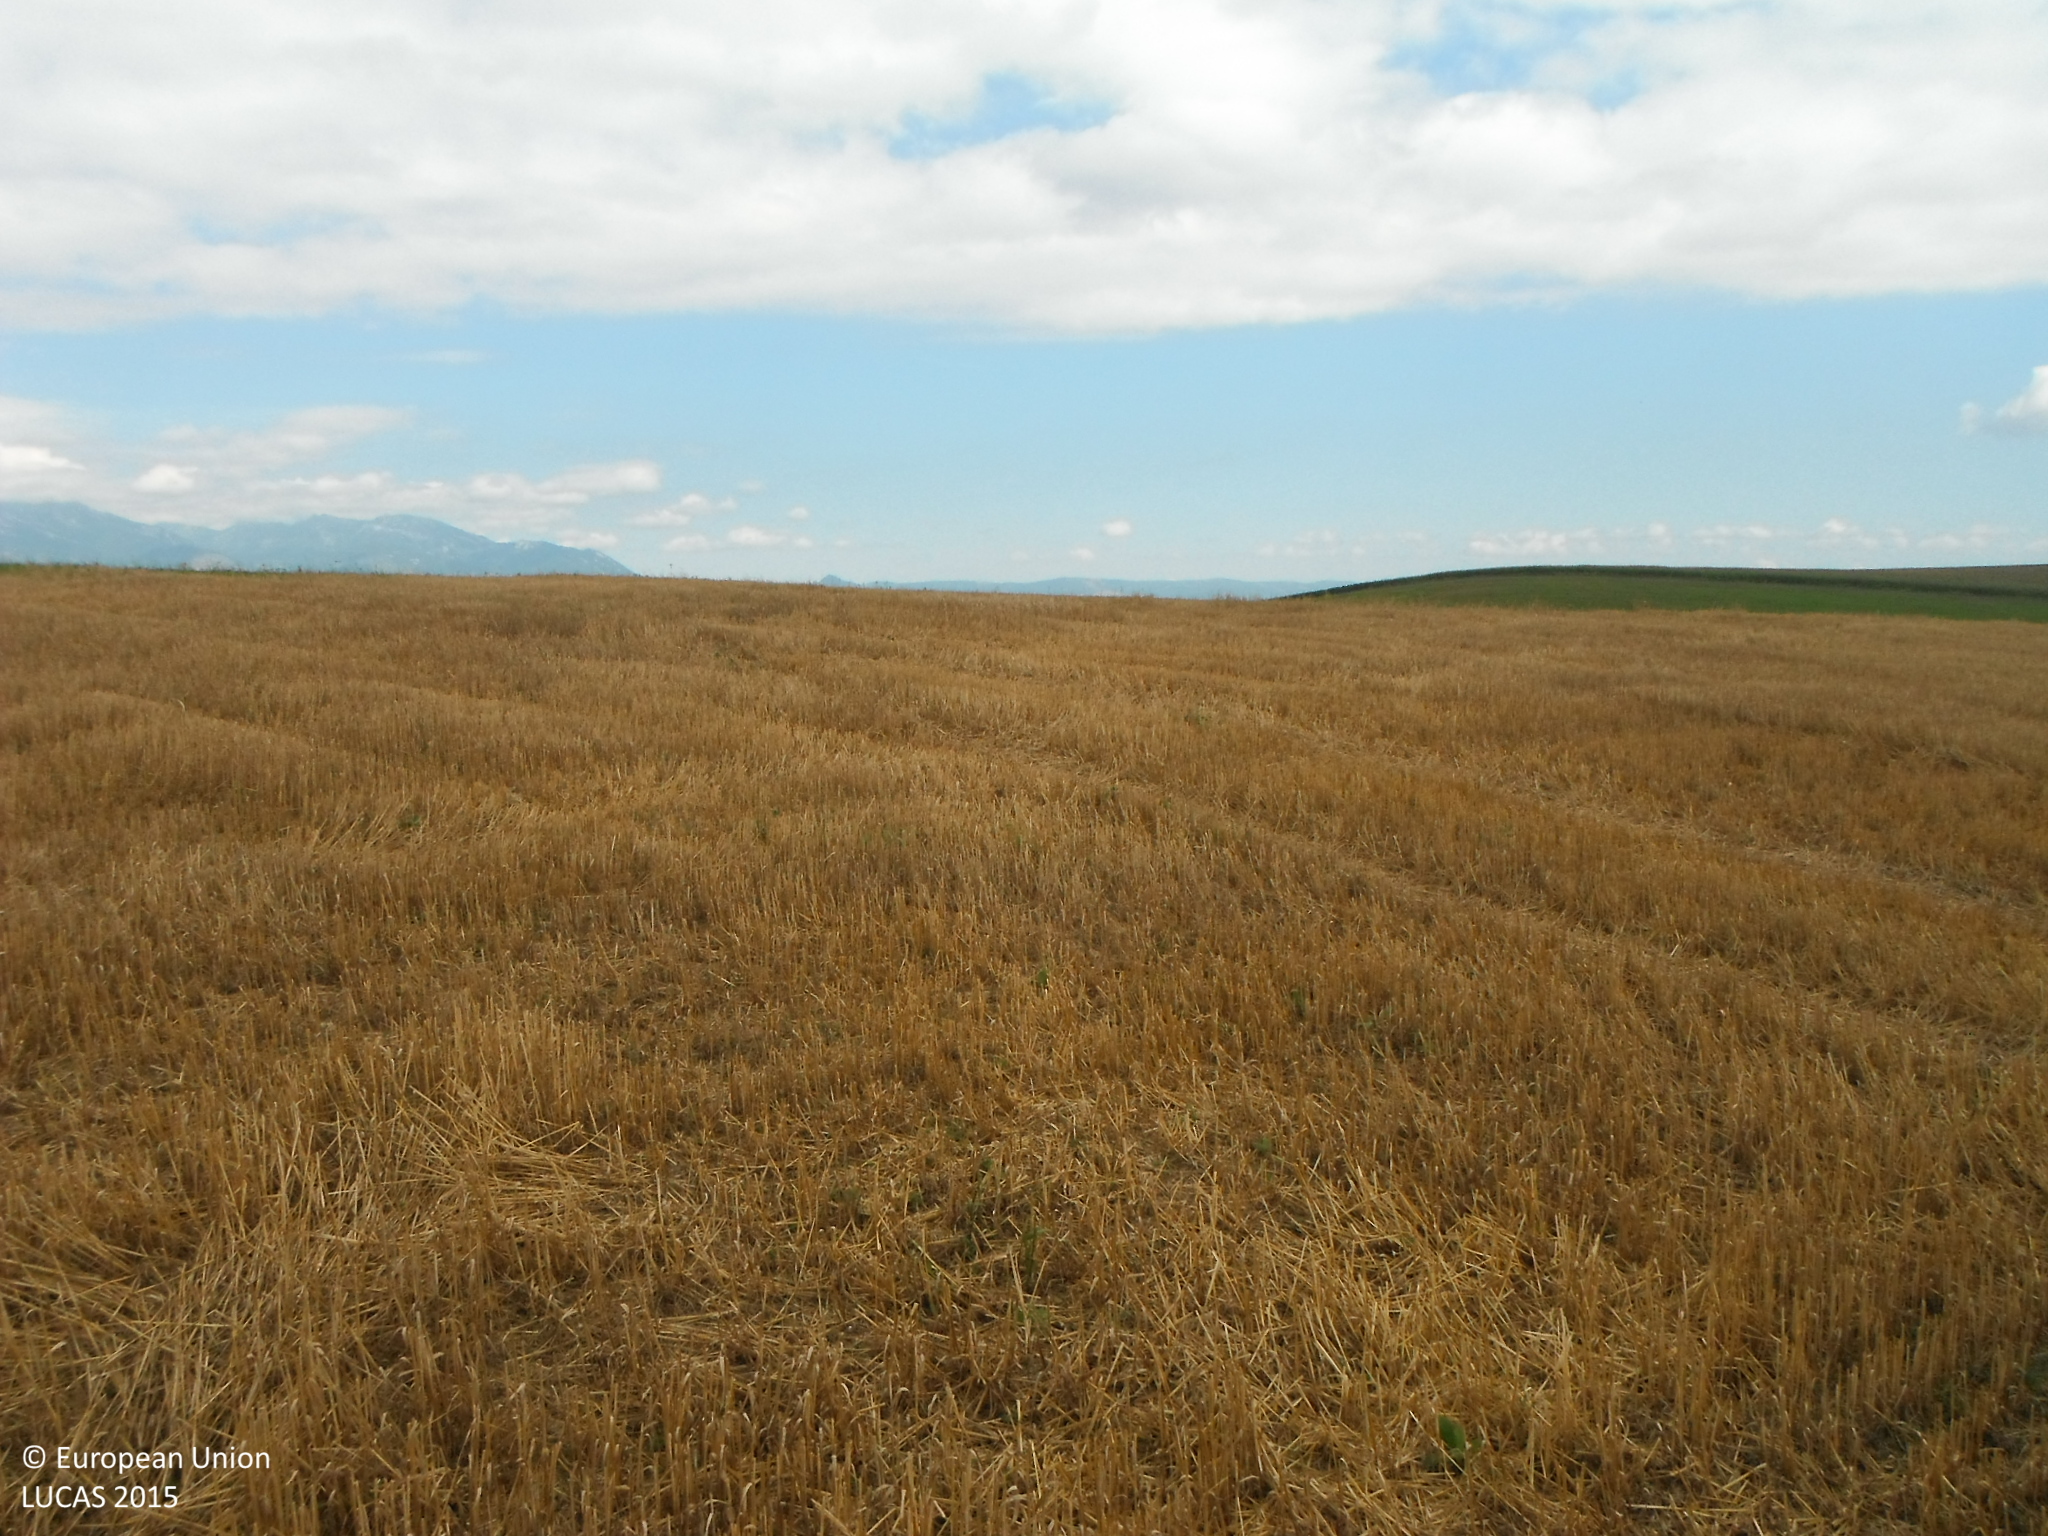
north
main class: Cropland
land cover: Barley
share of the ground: > 75 %
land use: Agriculture (excluding fallow land and kitchen gardens)
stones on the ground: 25 - 50 %
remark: Harvested field
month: August
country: SK
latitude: 49.0753
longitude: 20.3704
